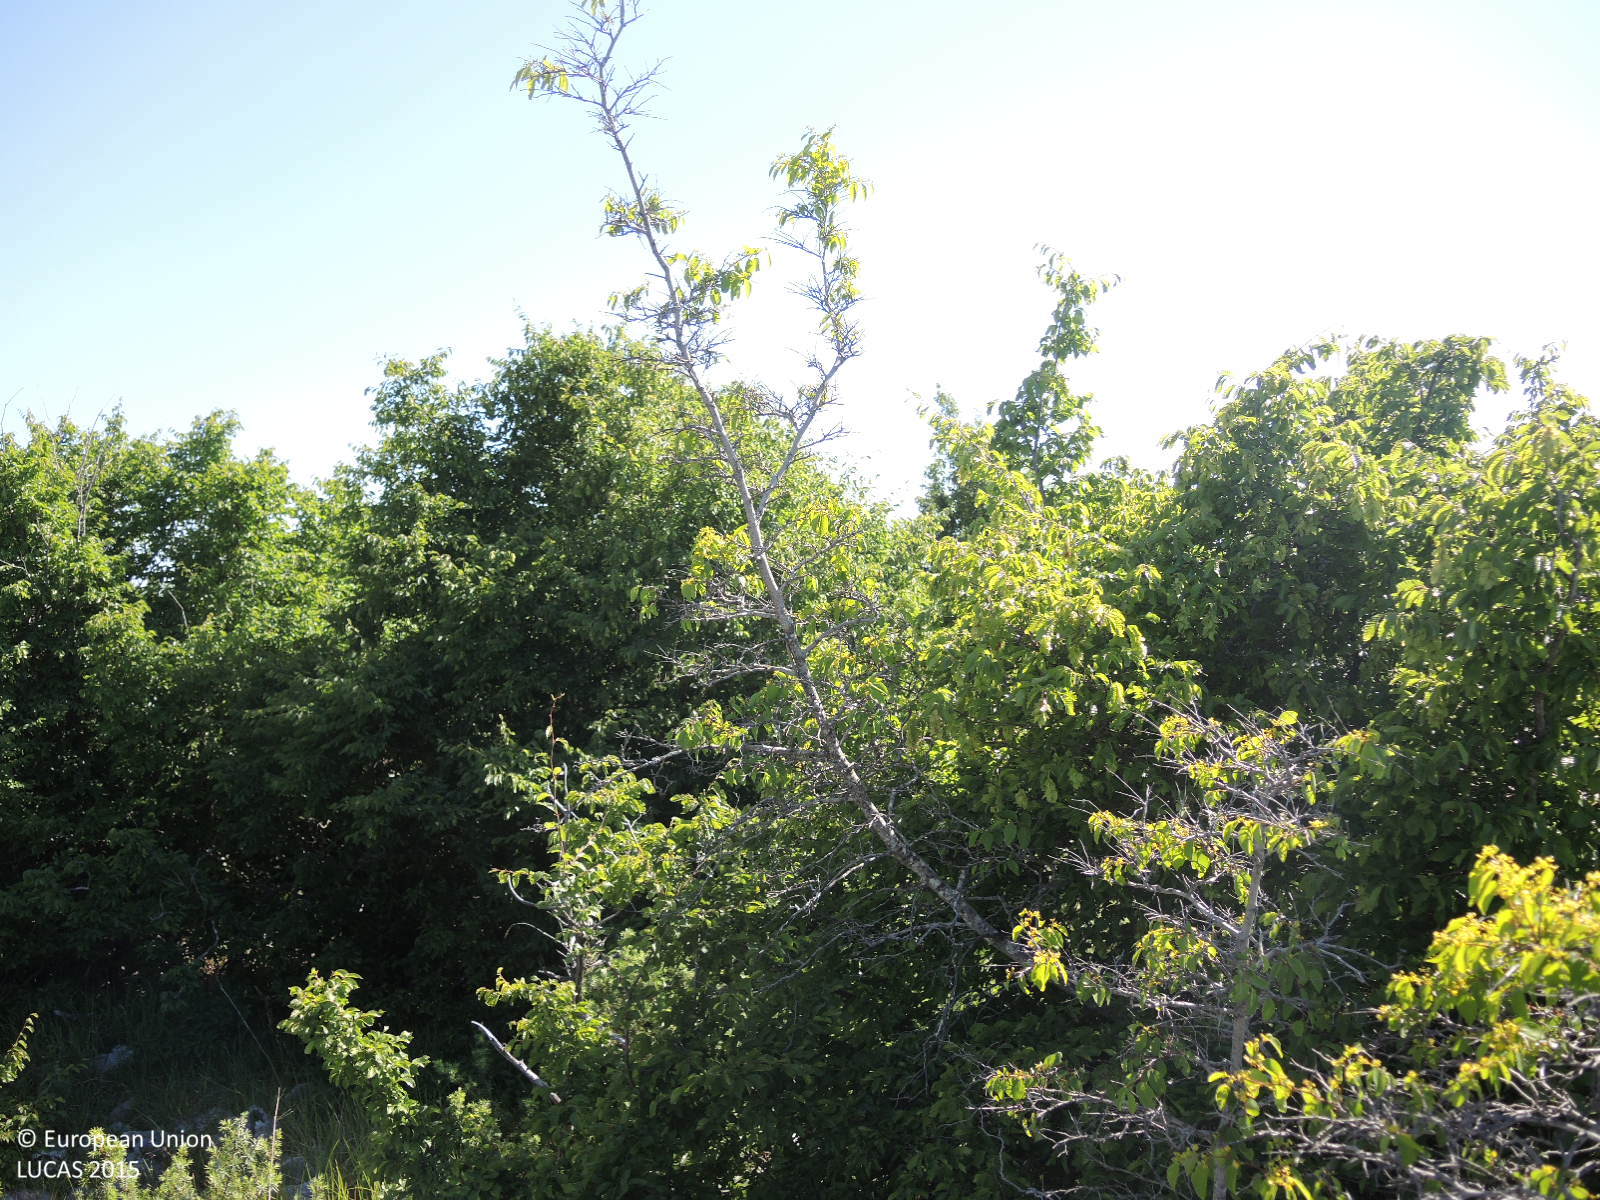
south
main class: Shrubland
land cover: Shrubland with sparse tree cover
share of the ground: 50 - 75 %
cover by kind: shrubs 50 %, unconsolidated bare surface 30 %, herbaceous plants 10 %, broadleaved forest trees 5 %, consolidated bare surface 5 %
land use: Semi-natural and natural areas not in use
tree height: < 5 m
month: May
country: HR
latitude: 43.9290
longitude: 15.9084
